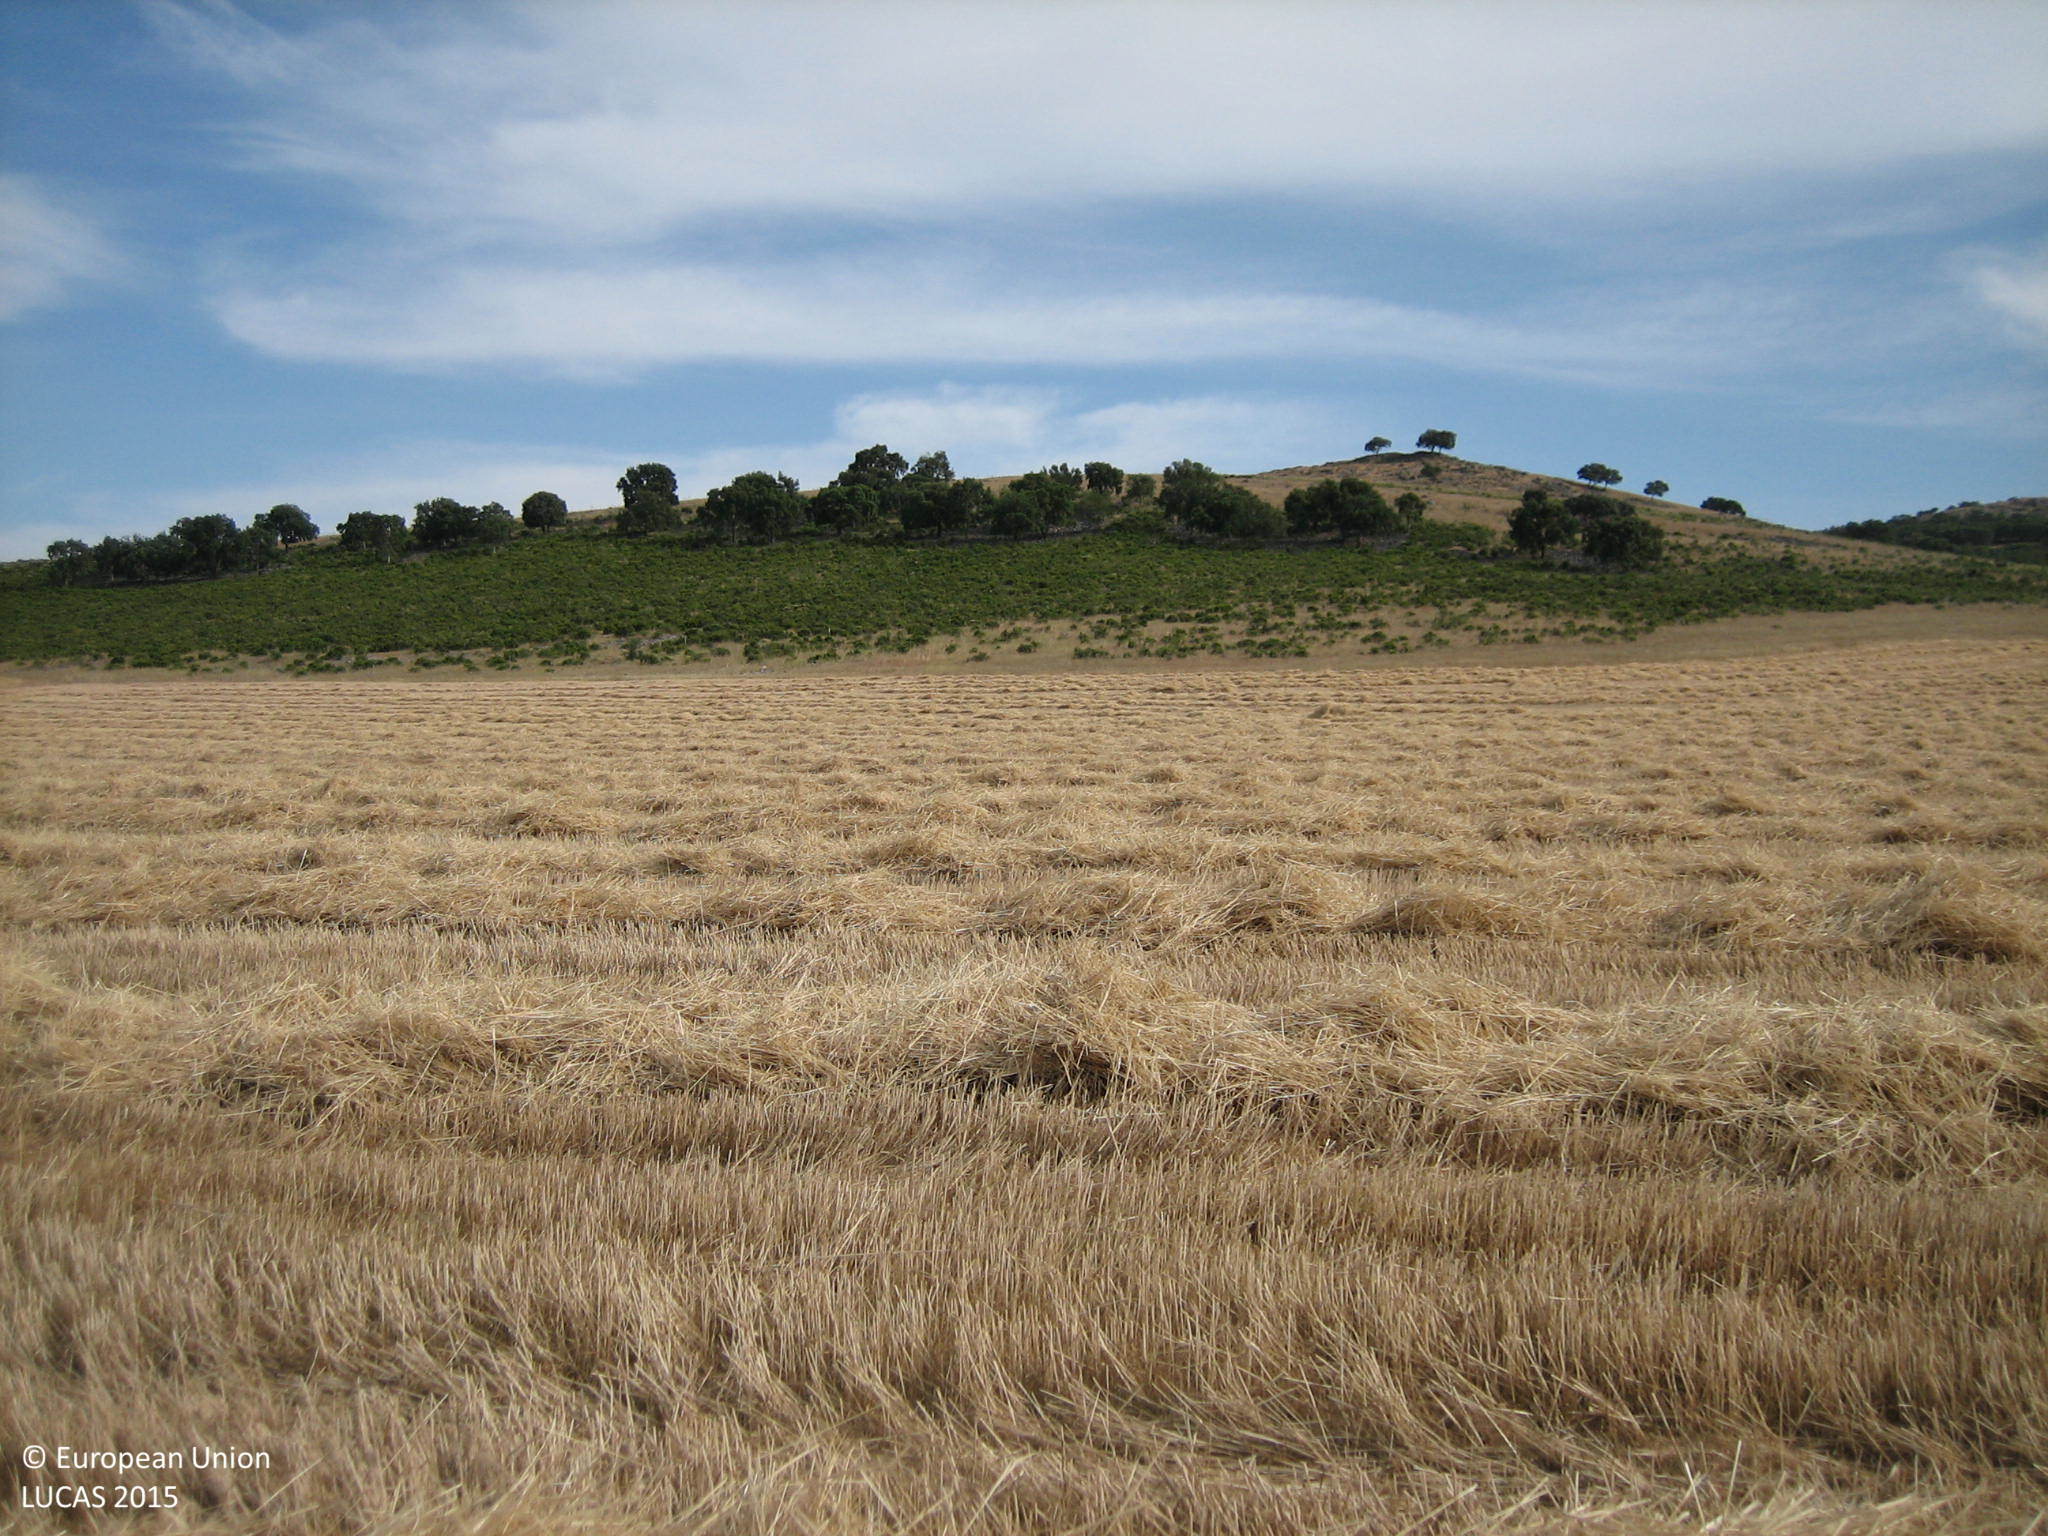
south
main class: Cropland
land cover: Durum wheat
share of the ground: 10 - 25 %
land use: Agriculture (excluding fallow land and kitchen gardens)
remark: Harvested field
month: June
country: ES
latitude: 39.0939
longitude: -4.7283
